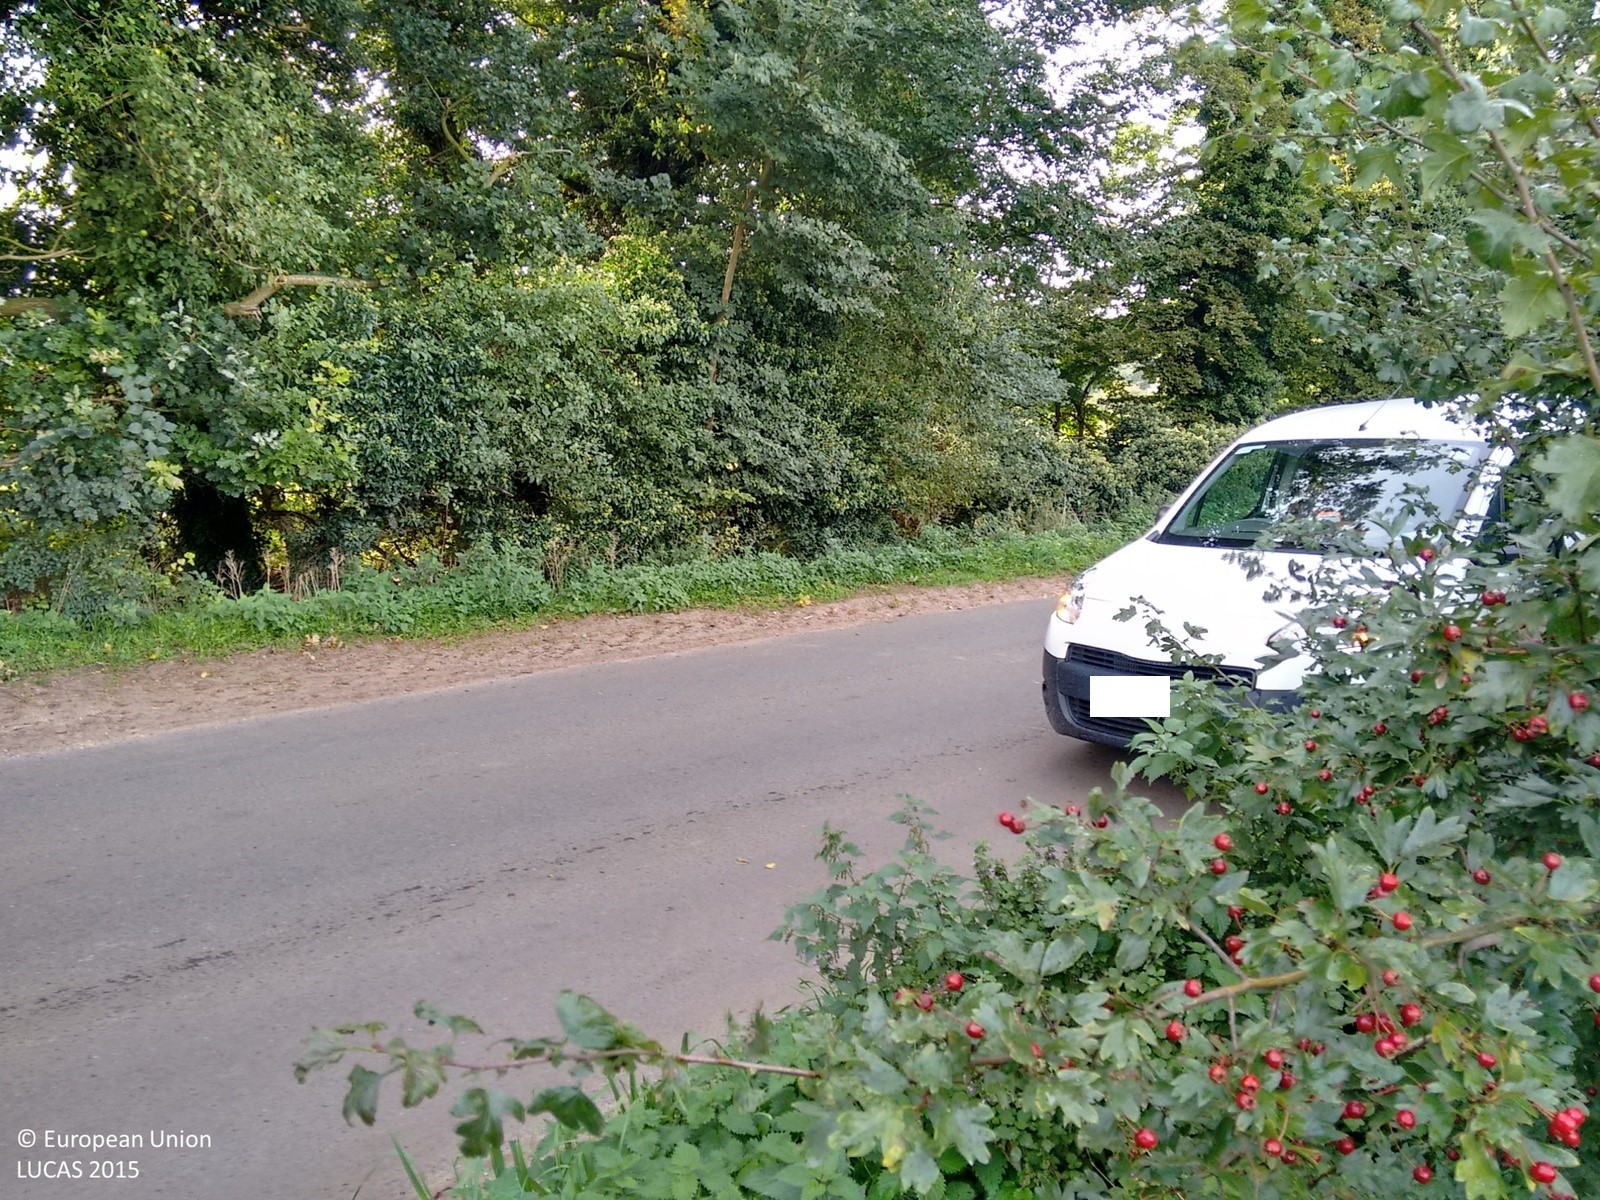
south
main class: Grassland
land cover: Grassland without tree/shrub cover
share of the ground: > 75 %
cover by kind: herbaceous plants 100 %
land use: Agriculture (excluding fallow land and kitchen gardens)
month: September
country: GB
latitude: 52.4211
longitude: 0.8441
